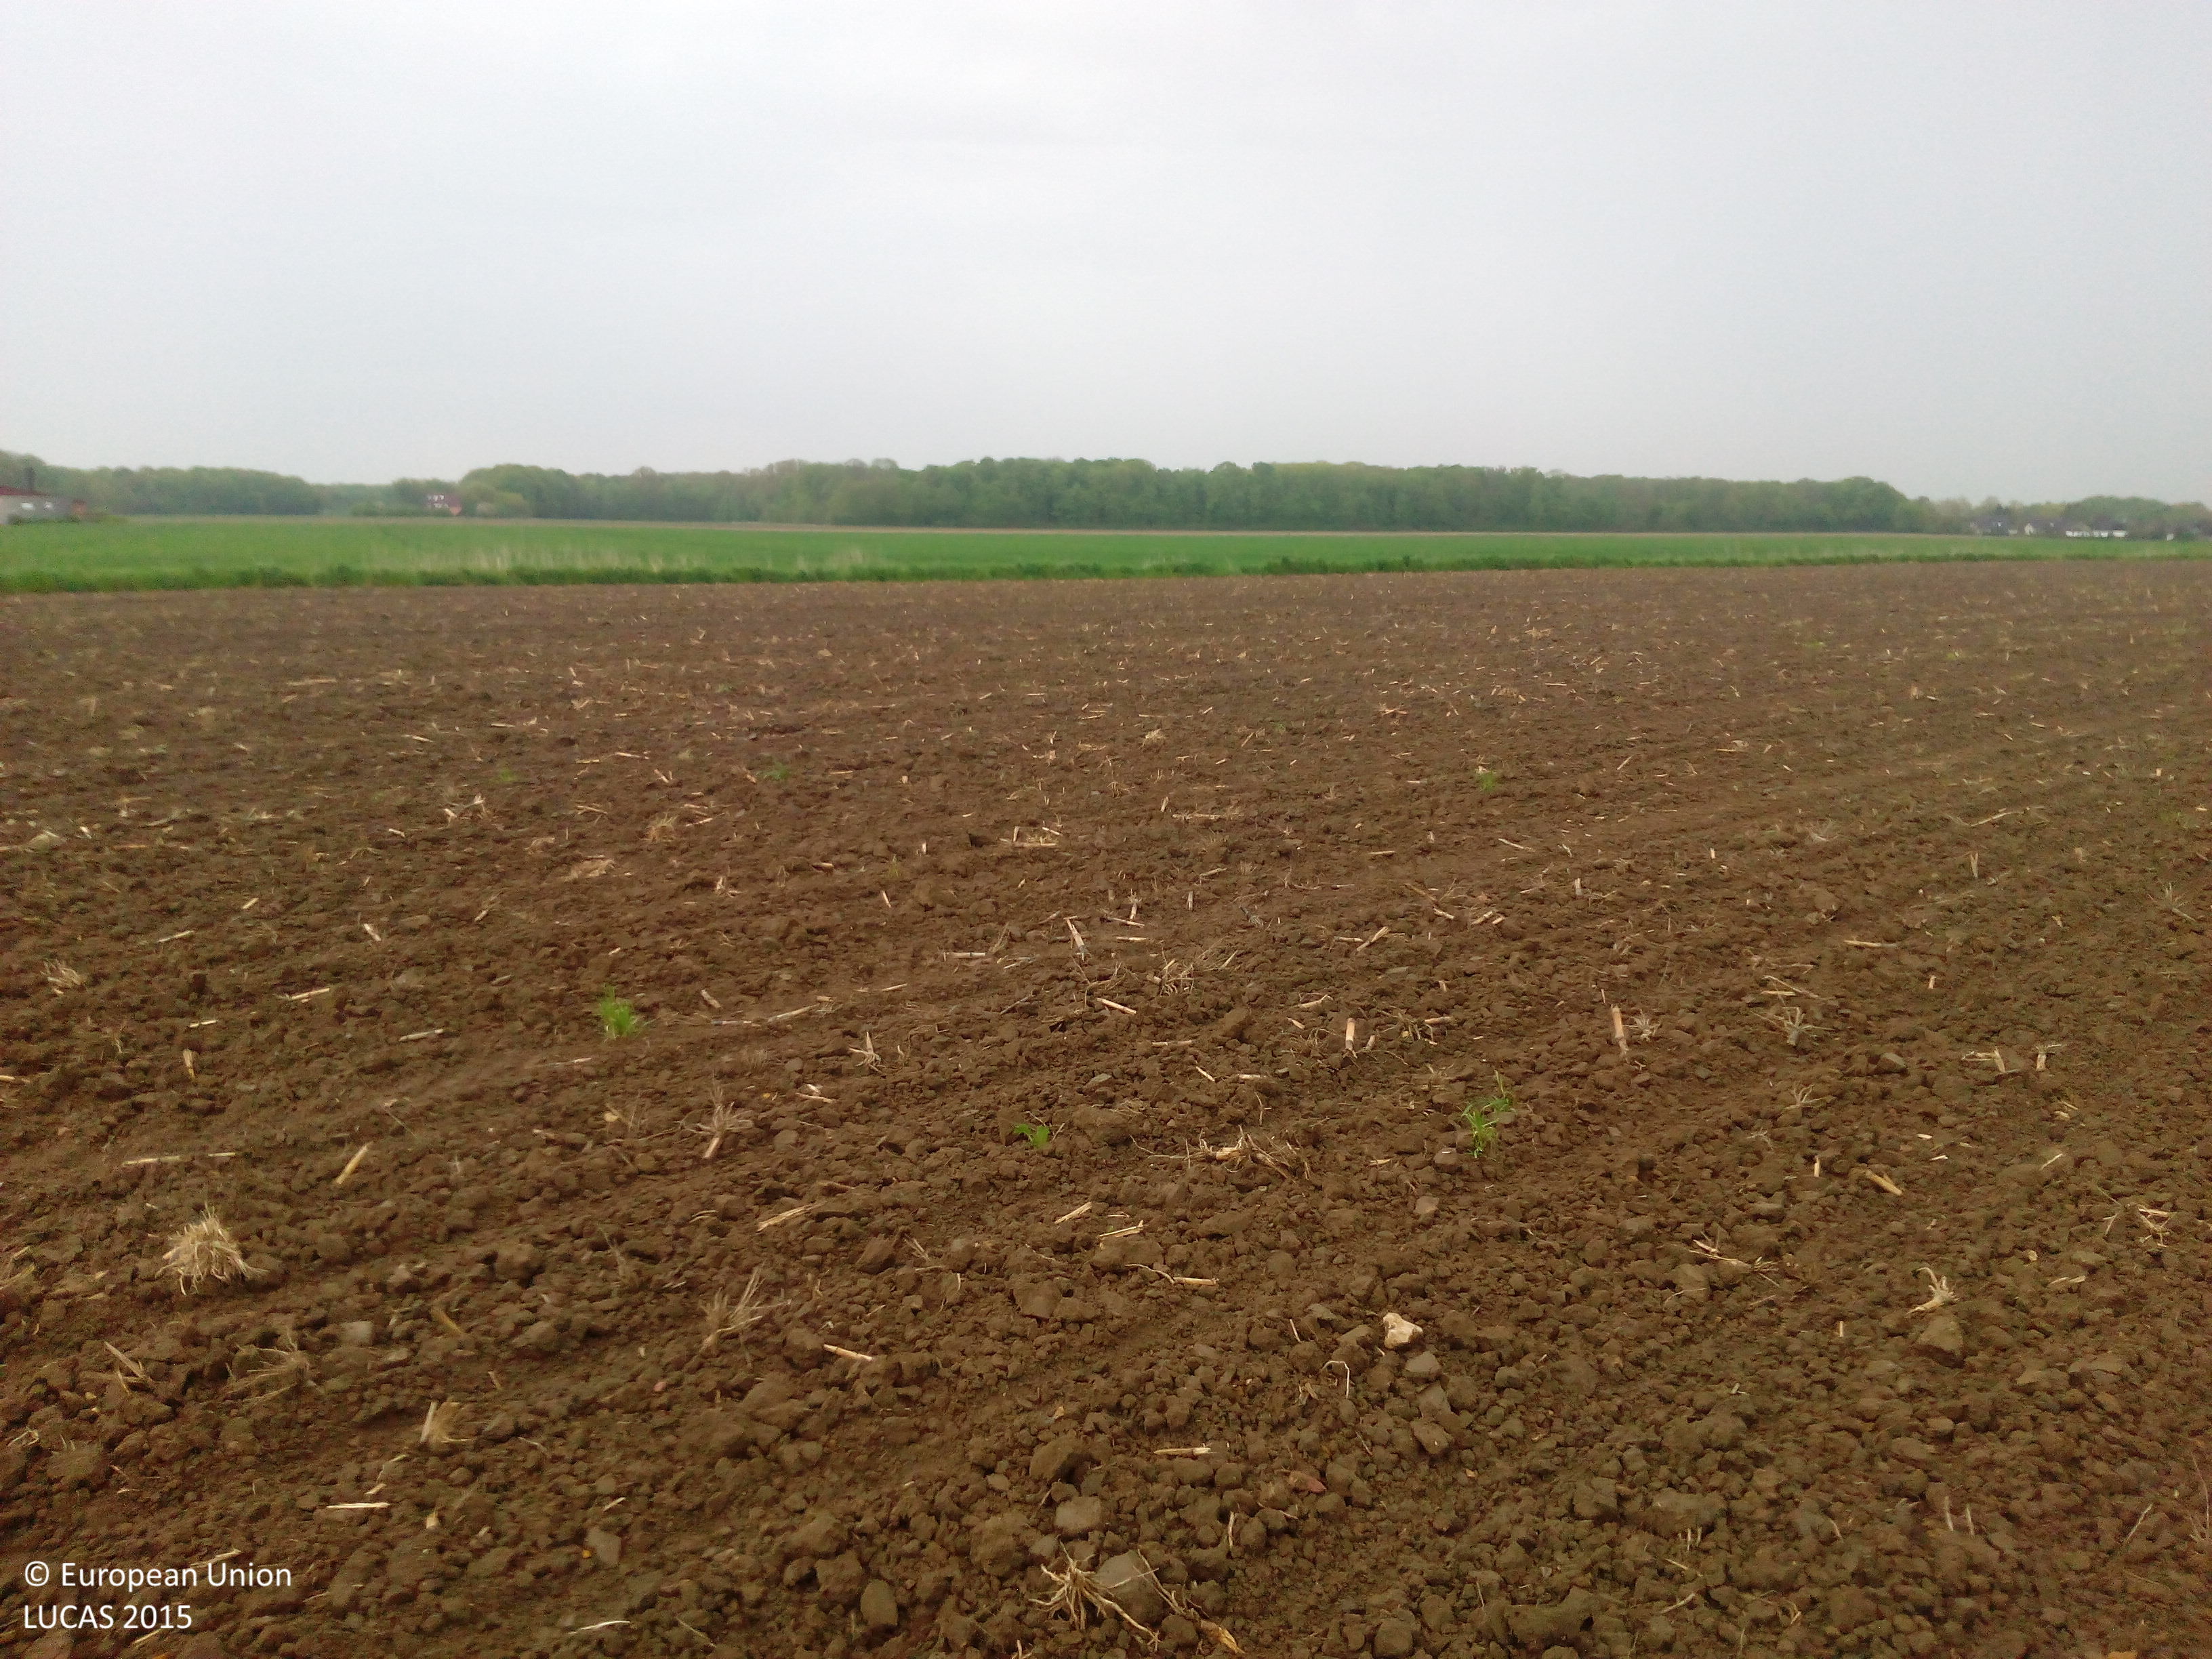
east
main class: Cropland
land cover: Maize
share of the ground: < 10 %
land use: Agriculture (excluding fallow land and kitchen gardens)
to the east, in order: Maize; Ditches and canals; Common wheat
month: May
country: DE
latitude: 51.8648
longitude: 7.4589
